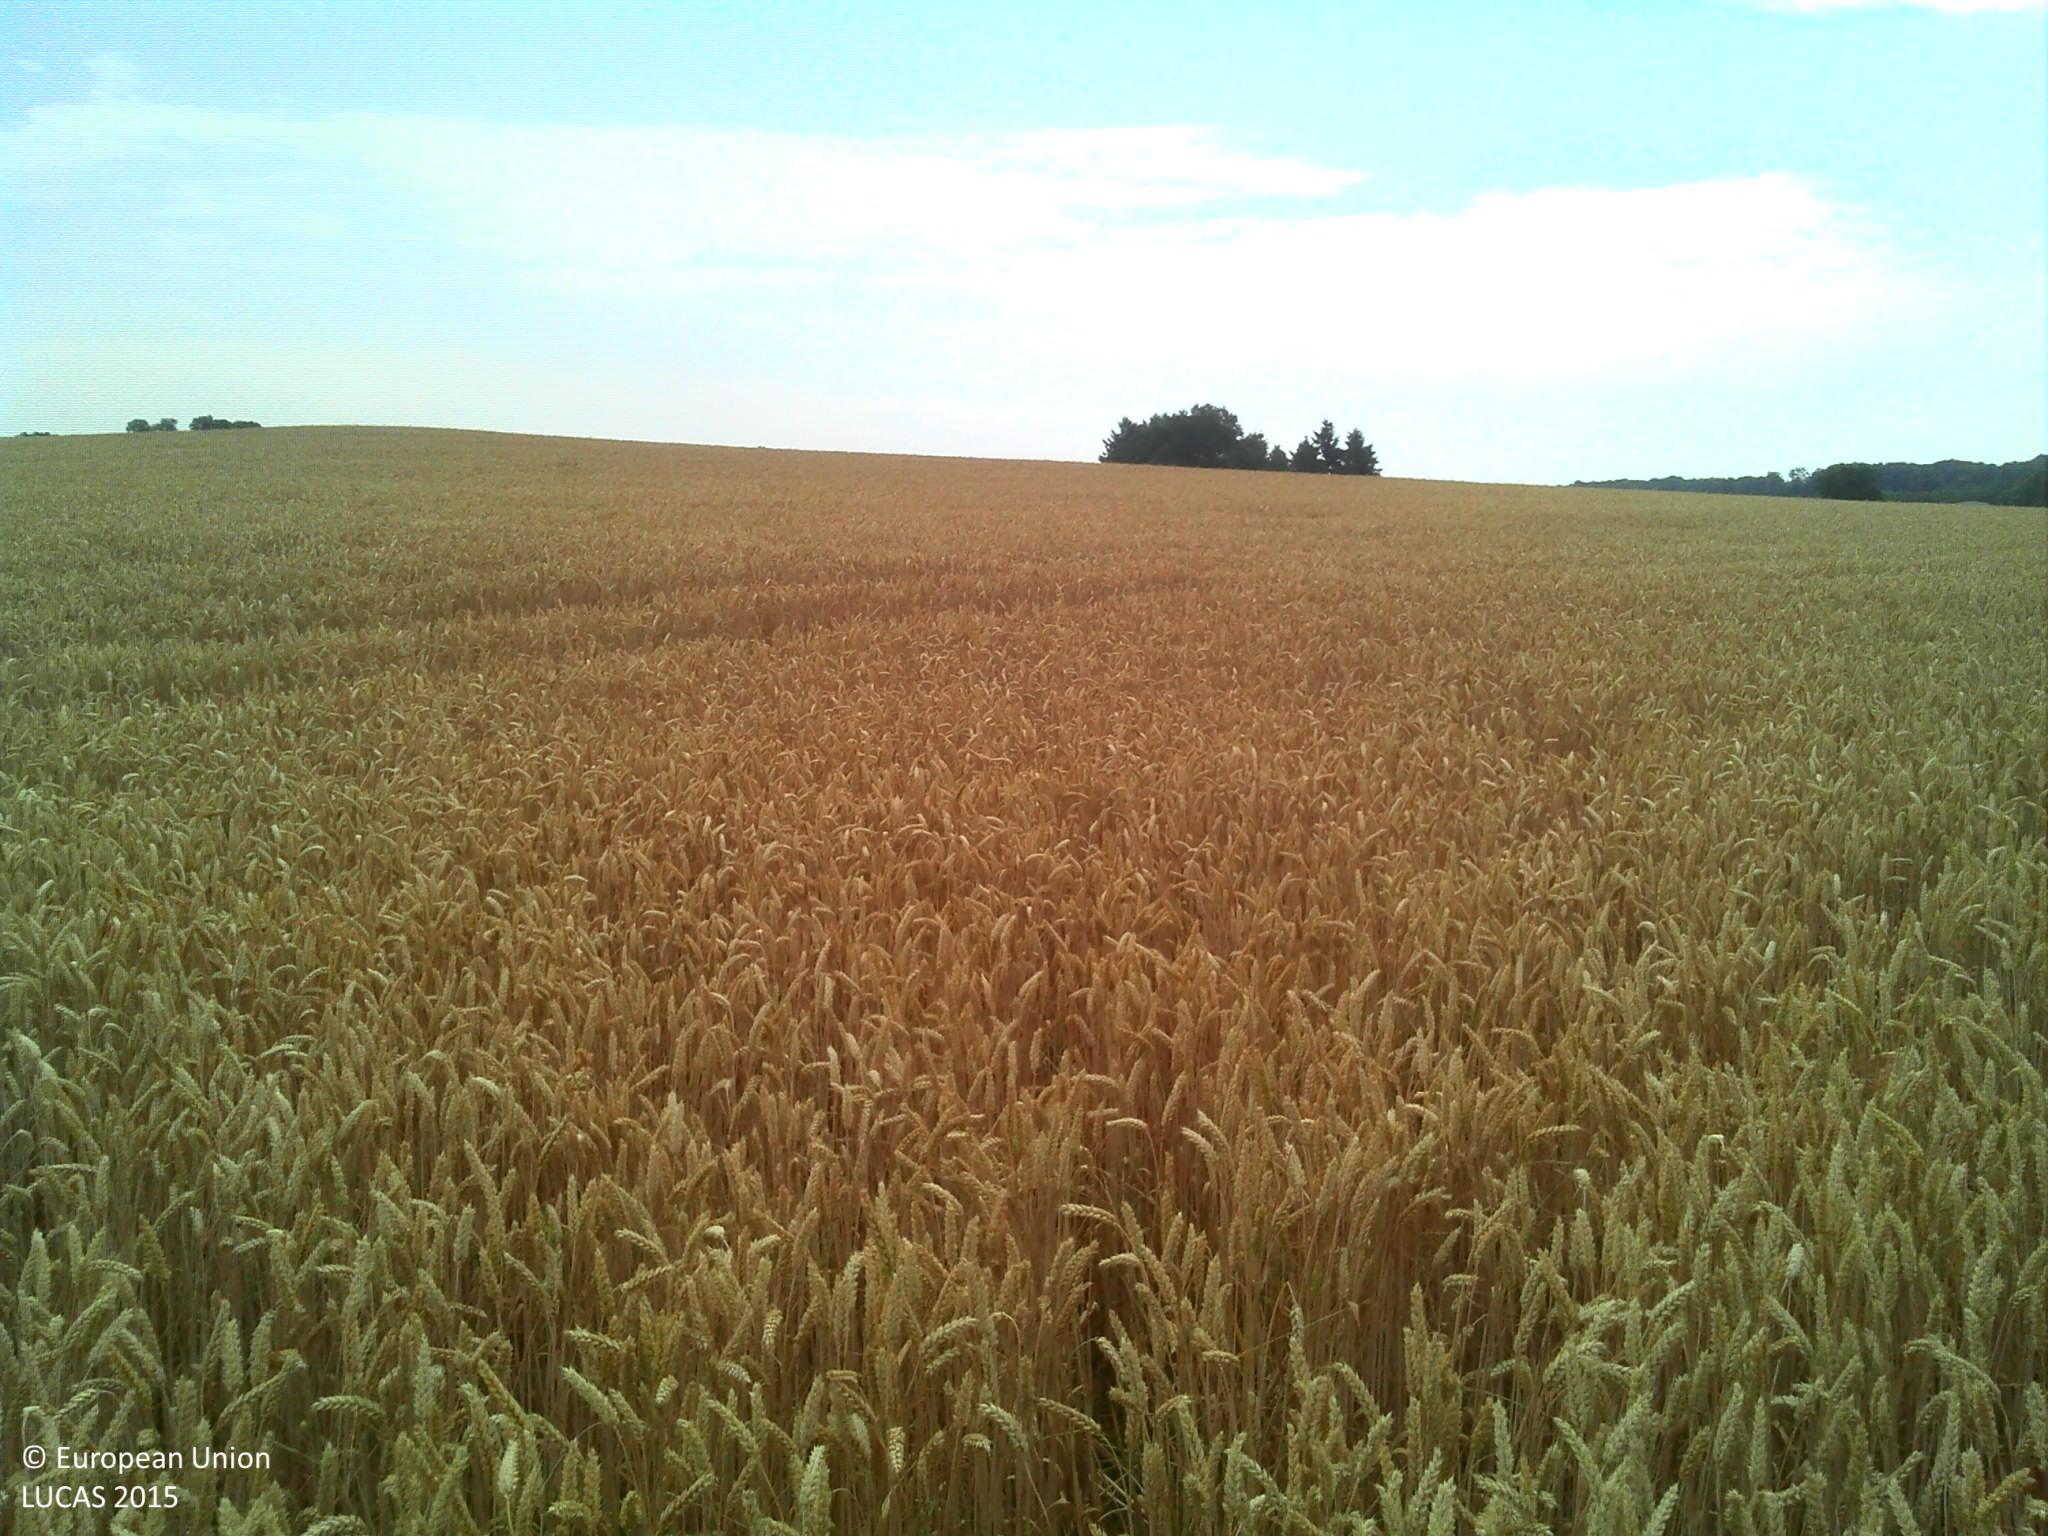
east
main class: Cropland
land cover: Common wheat
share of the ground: > 75 %
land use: Agriculture (excluding fallow land and kitchen gardens)
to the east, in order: Common wheat
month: July
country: FR
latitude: 49.0862
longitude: 3.3242
